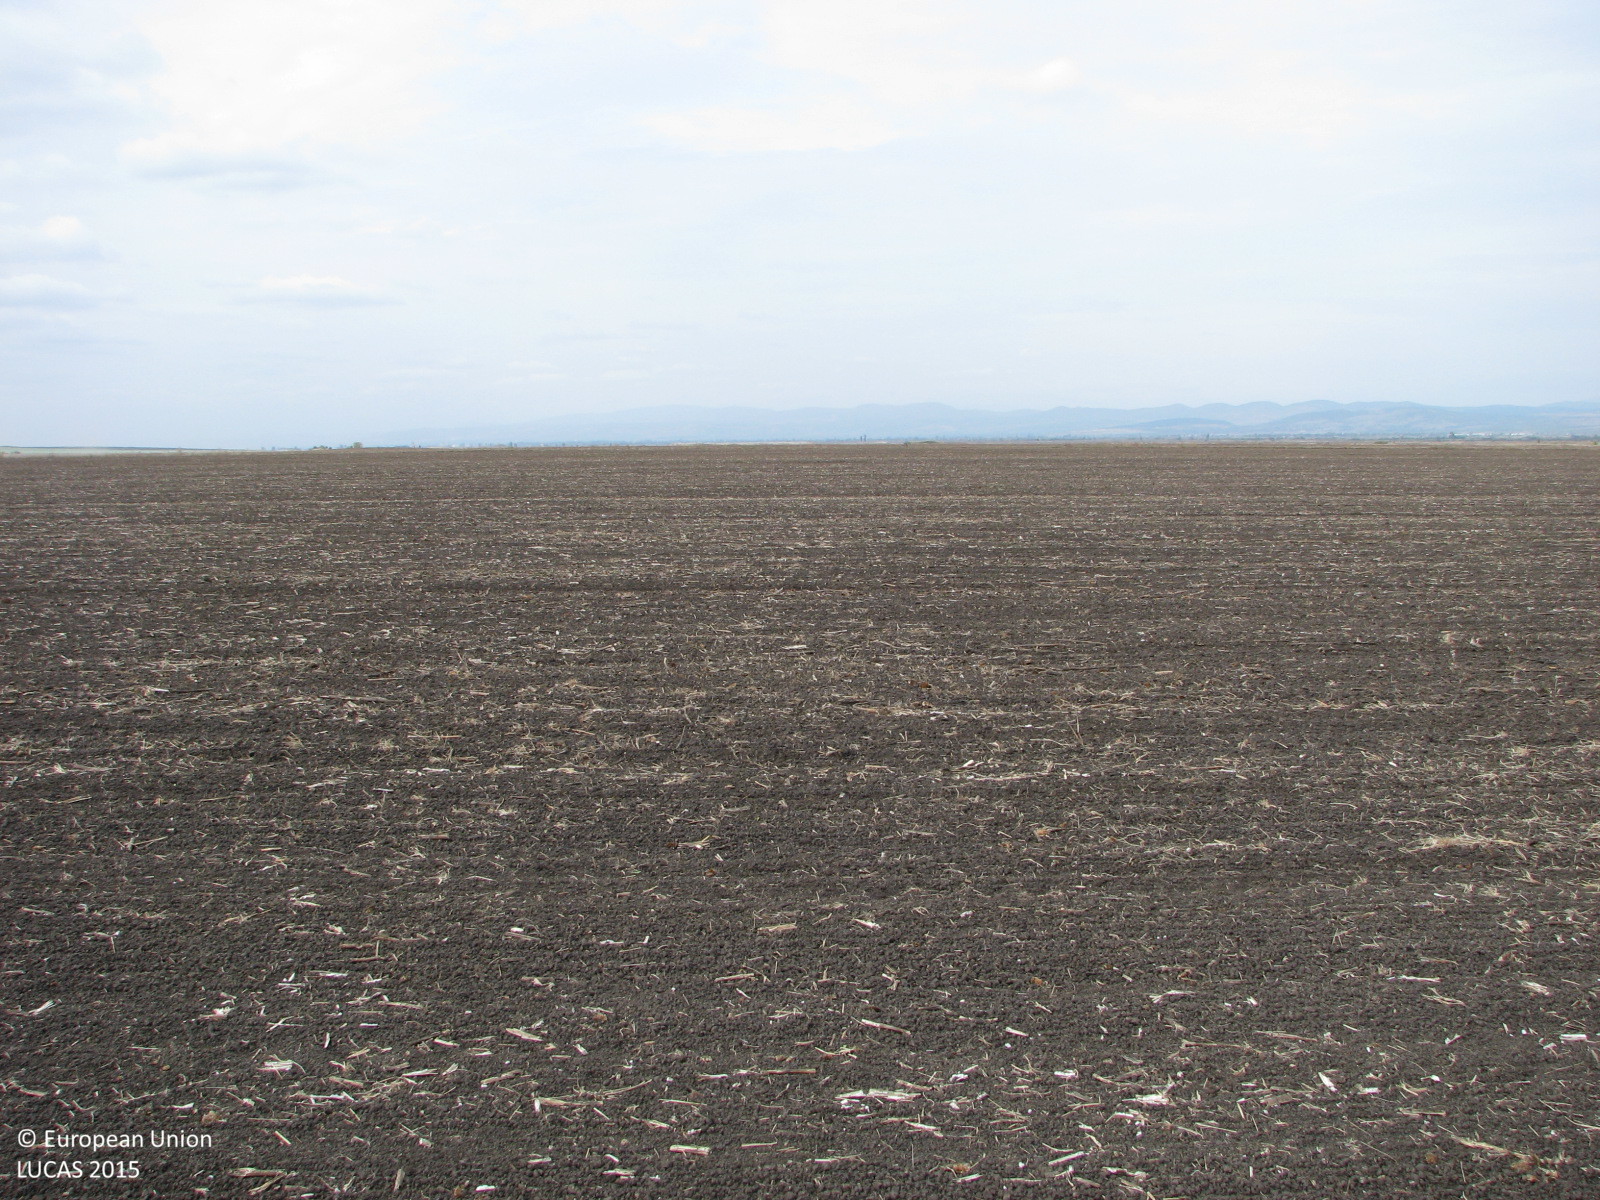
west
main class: Cropland
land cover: Sunflower
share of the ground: < 10 %
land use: Agriculture (excluding fallow land and kitchen gardens)
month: October
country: BG
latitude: 42.4866
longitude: 26.1553
